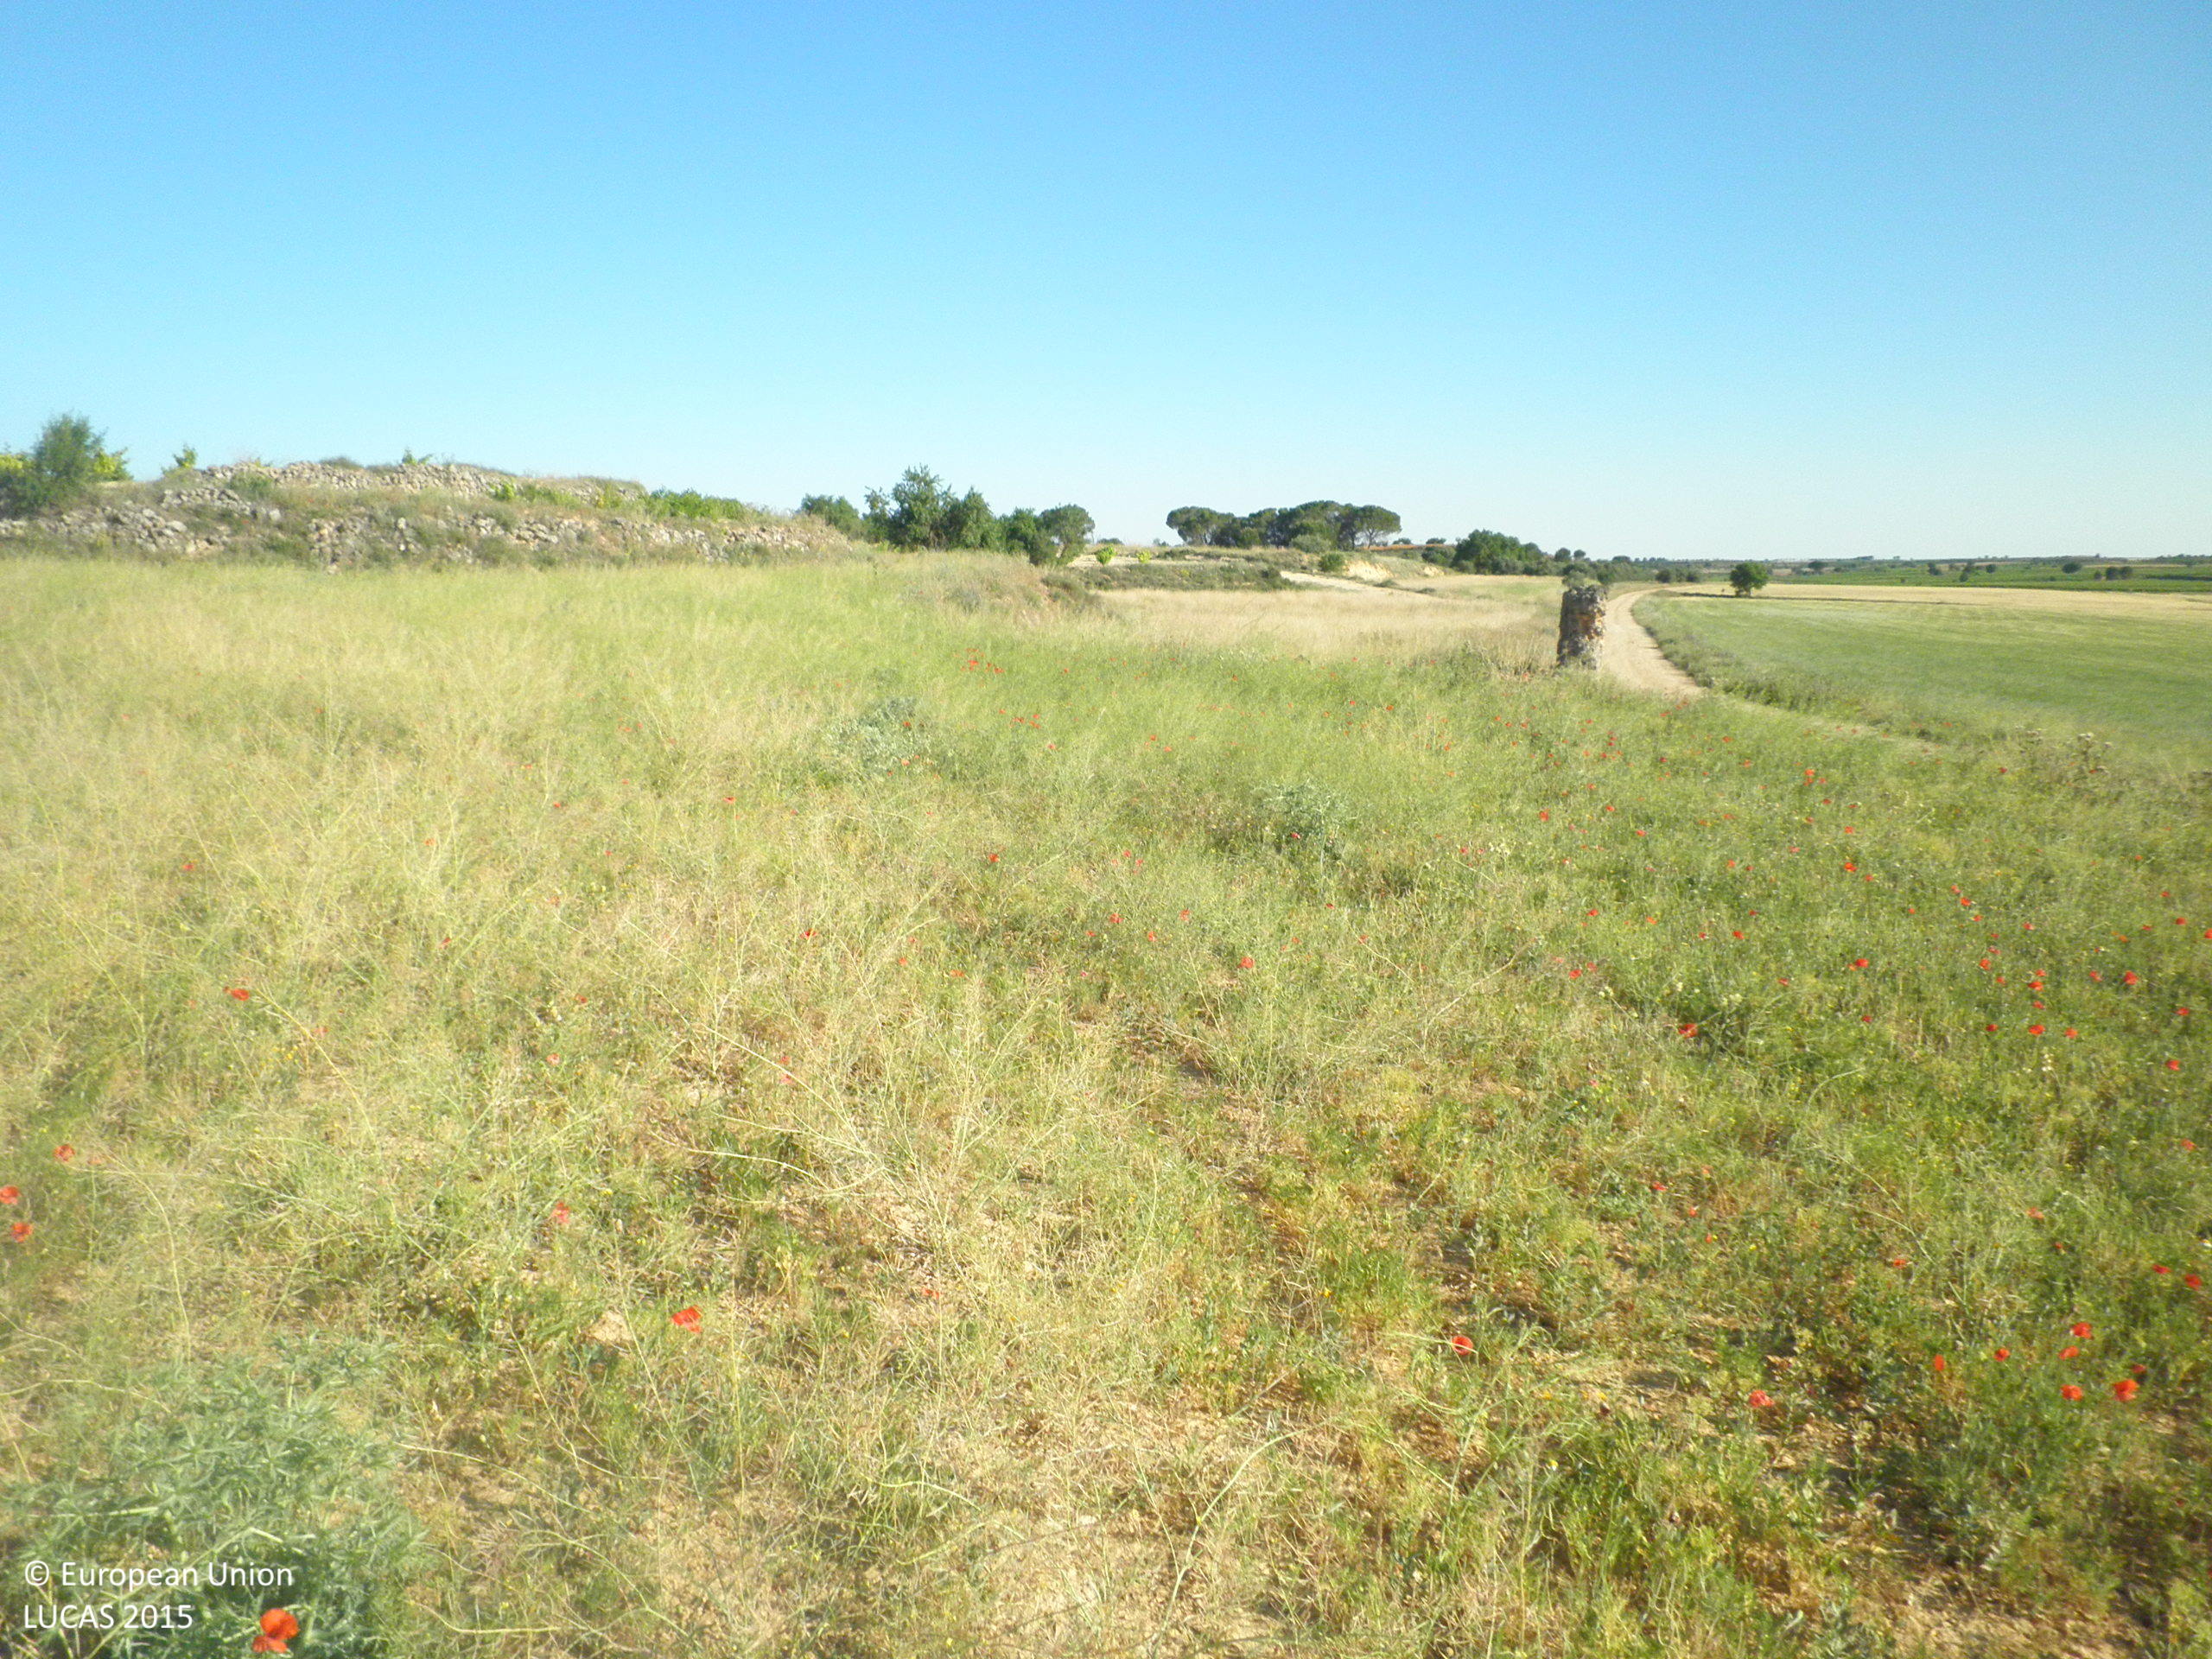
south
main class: Grassland
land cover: Spontaneously vegetated surfaces
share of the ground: > 75 %
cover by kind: herbaceous plants 75 %, unconsolidated bare surface 25 %
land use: Fallow land
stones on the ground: < 10 %
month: June
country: ES
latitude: 39.4129
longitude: -1.7470
